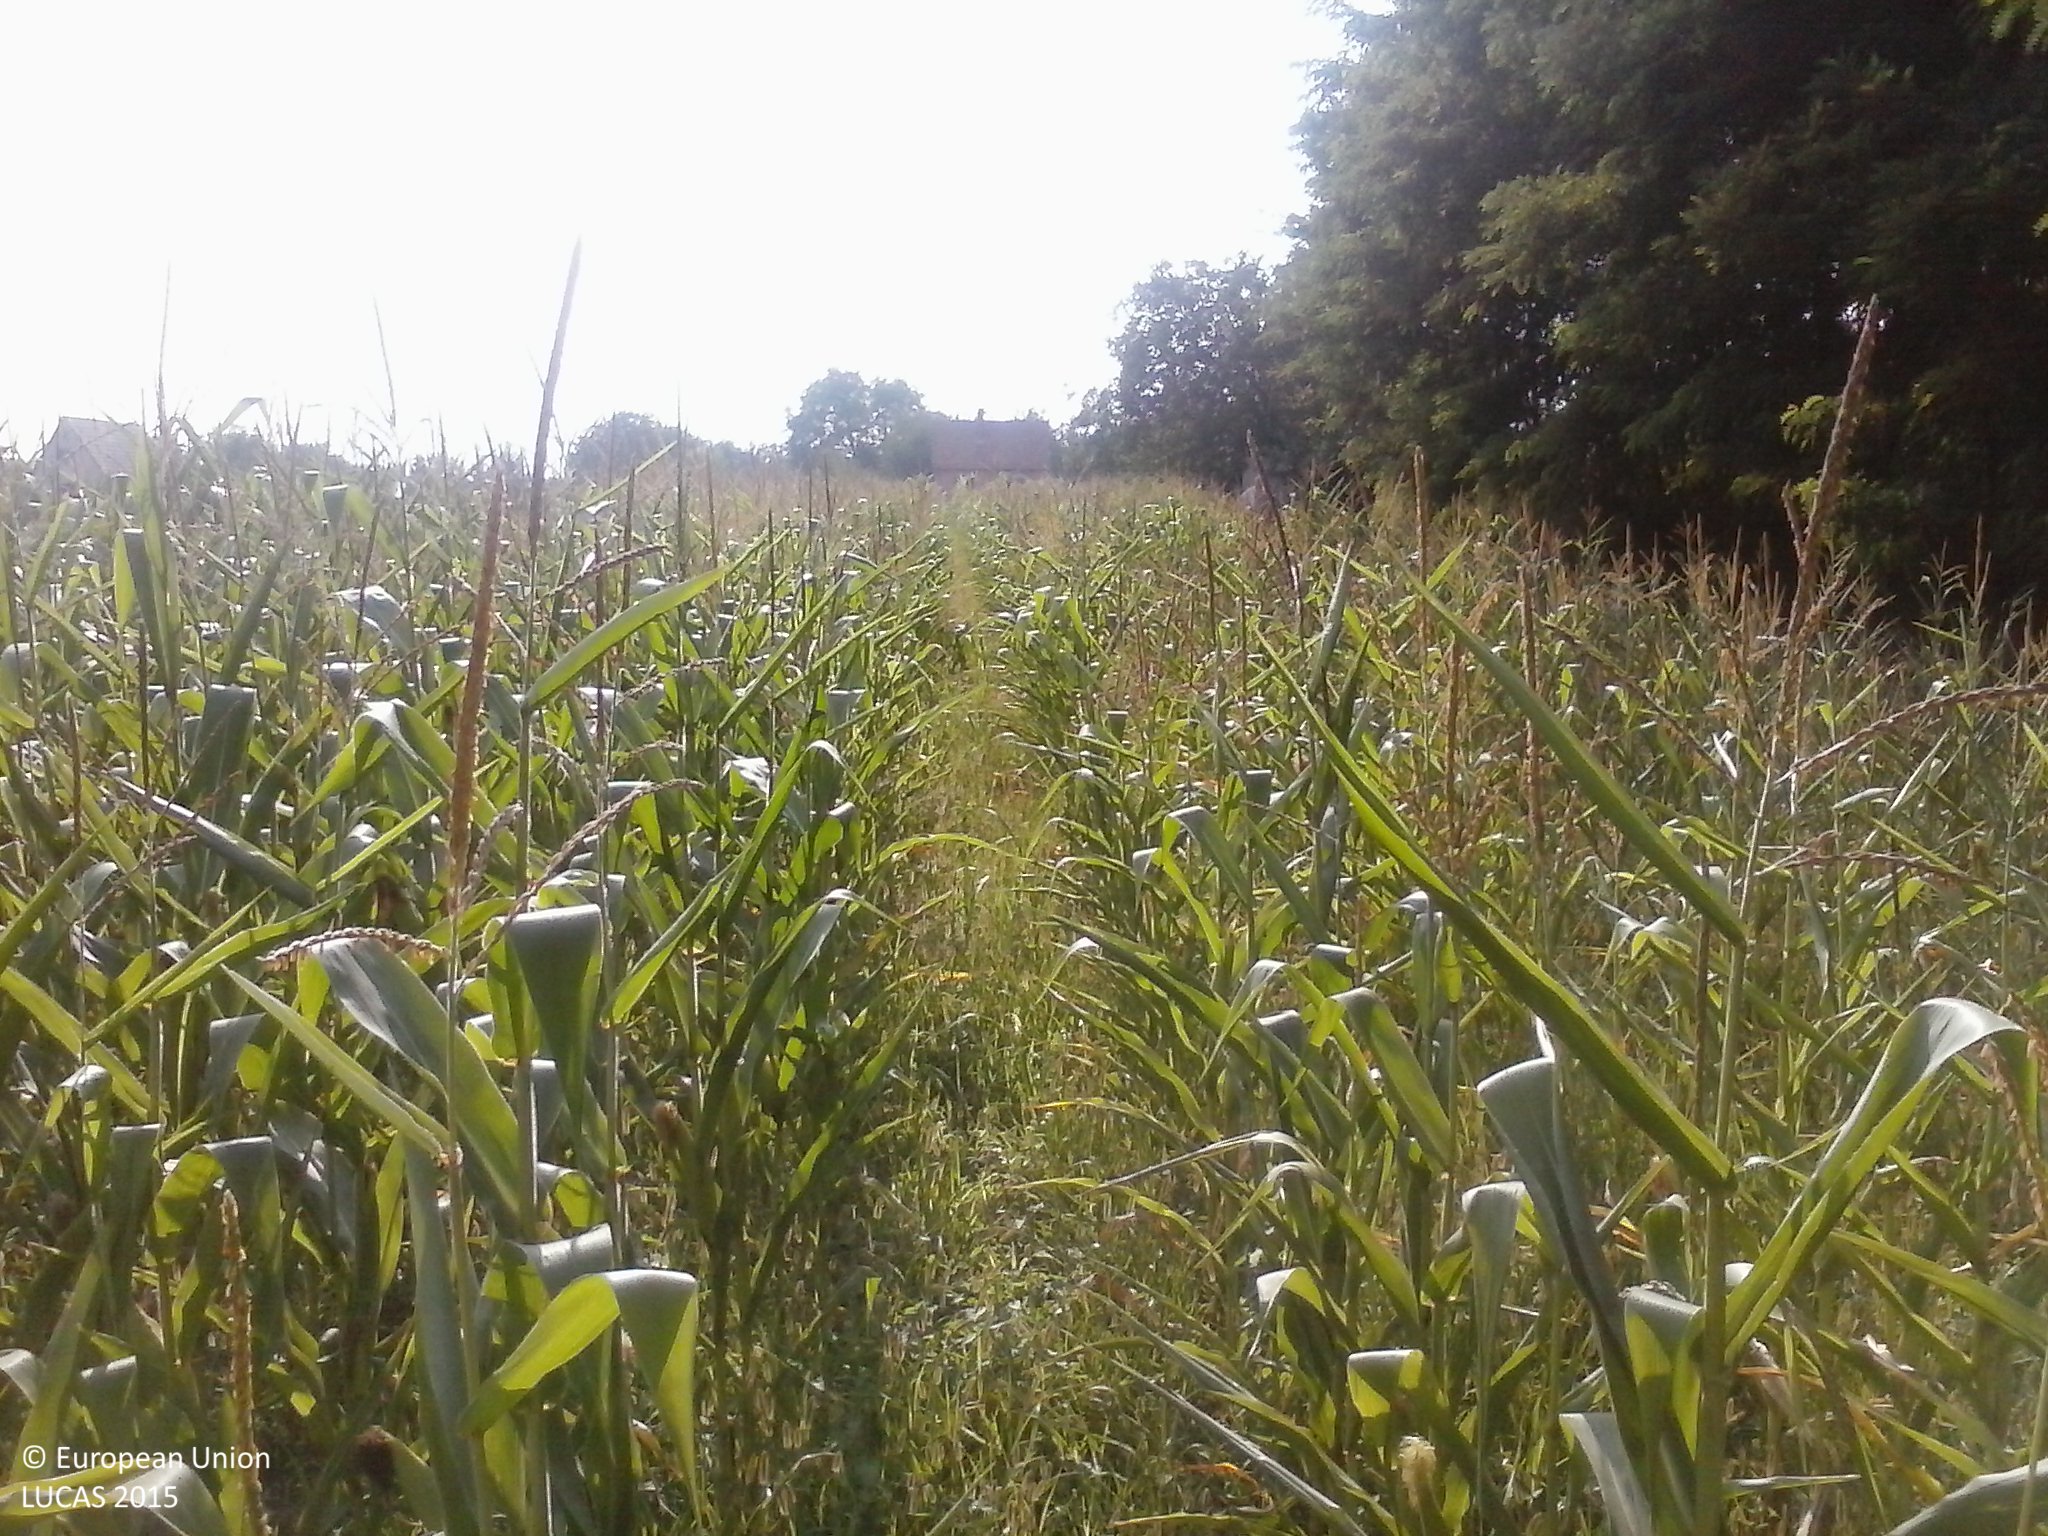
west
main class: Cropland
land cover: Maize
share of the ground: > 75 %
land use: Agriculture (excluding fallow land and kitchen gardens)
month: August
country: HU
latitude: 46.0859
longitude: 17.7772
